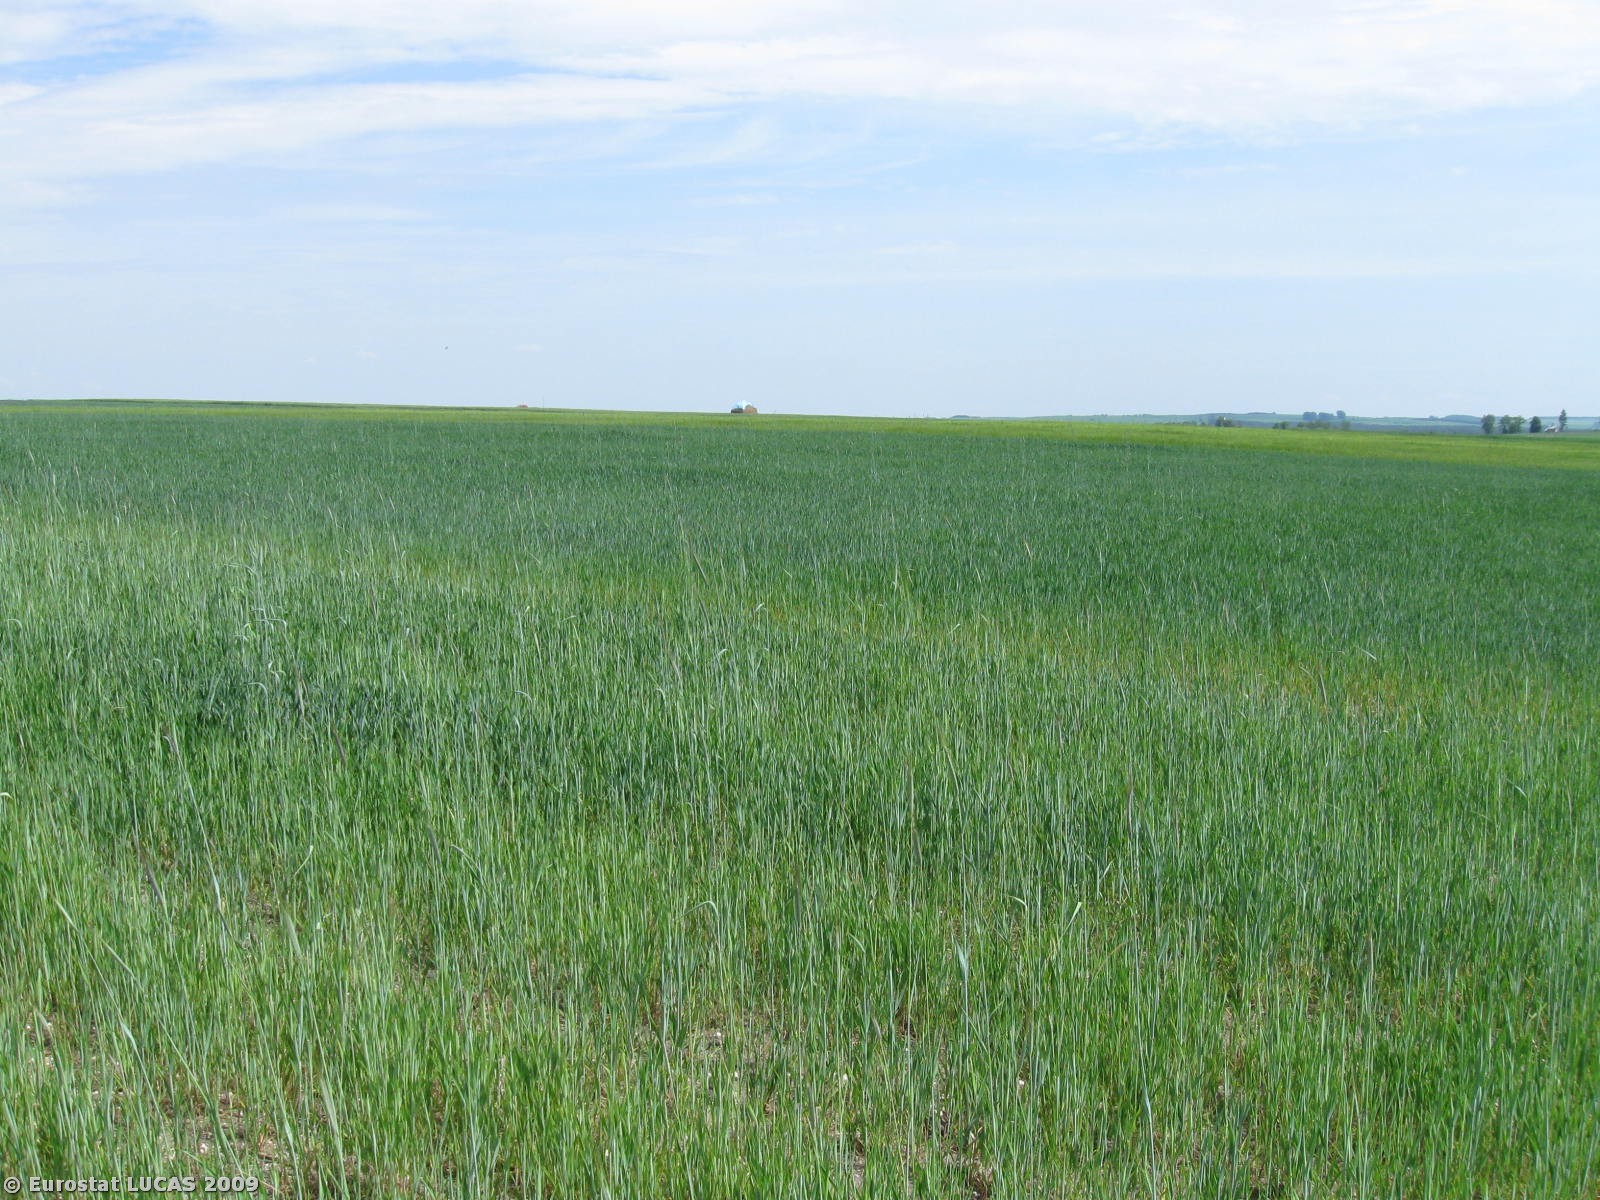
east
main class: Cropland
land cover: Rye
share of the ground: 50 - 75 %
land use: Agriculture (excluding fallow land and kitchen gardens)
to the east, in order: Rye; Common wheat; Barley; Grassland without tree/shrub cover
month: May
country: PL
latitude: 50.6854
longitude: 20.4120
